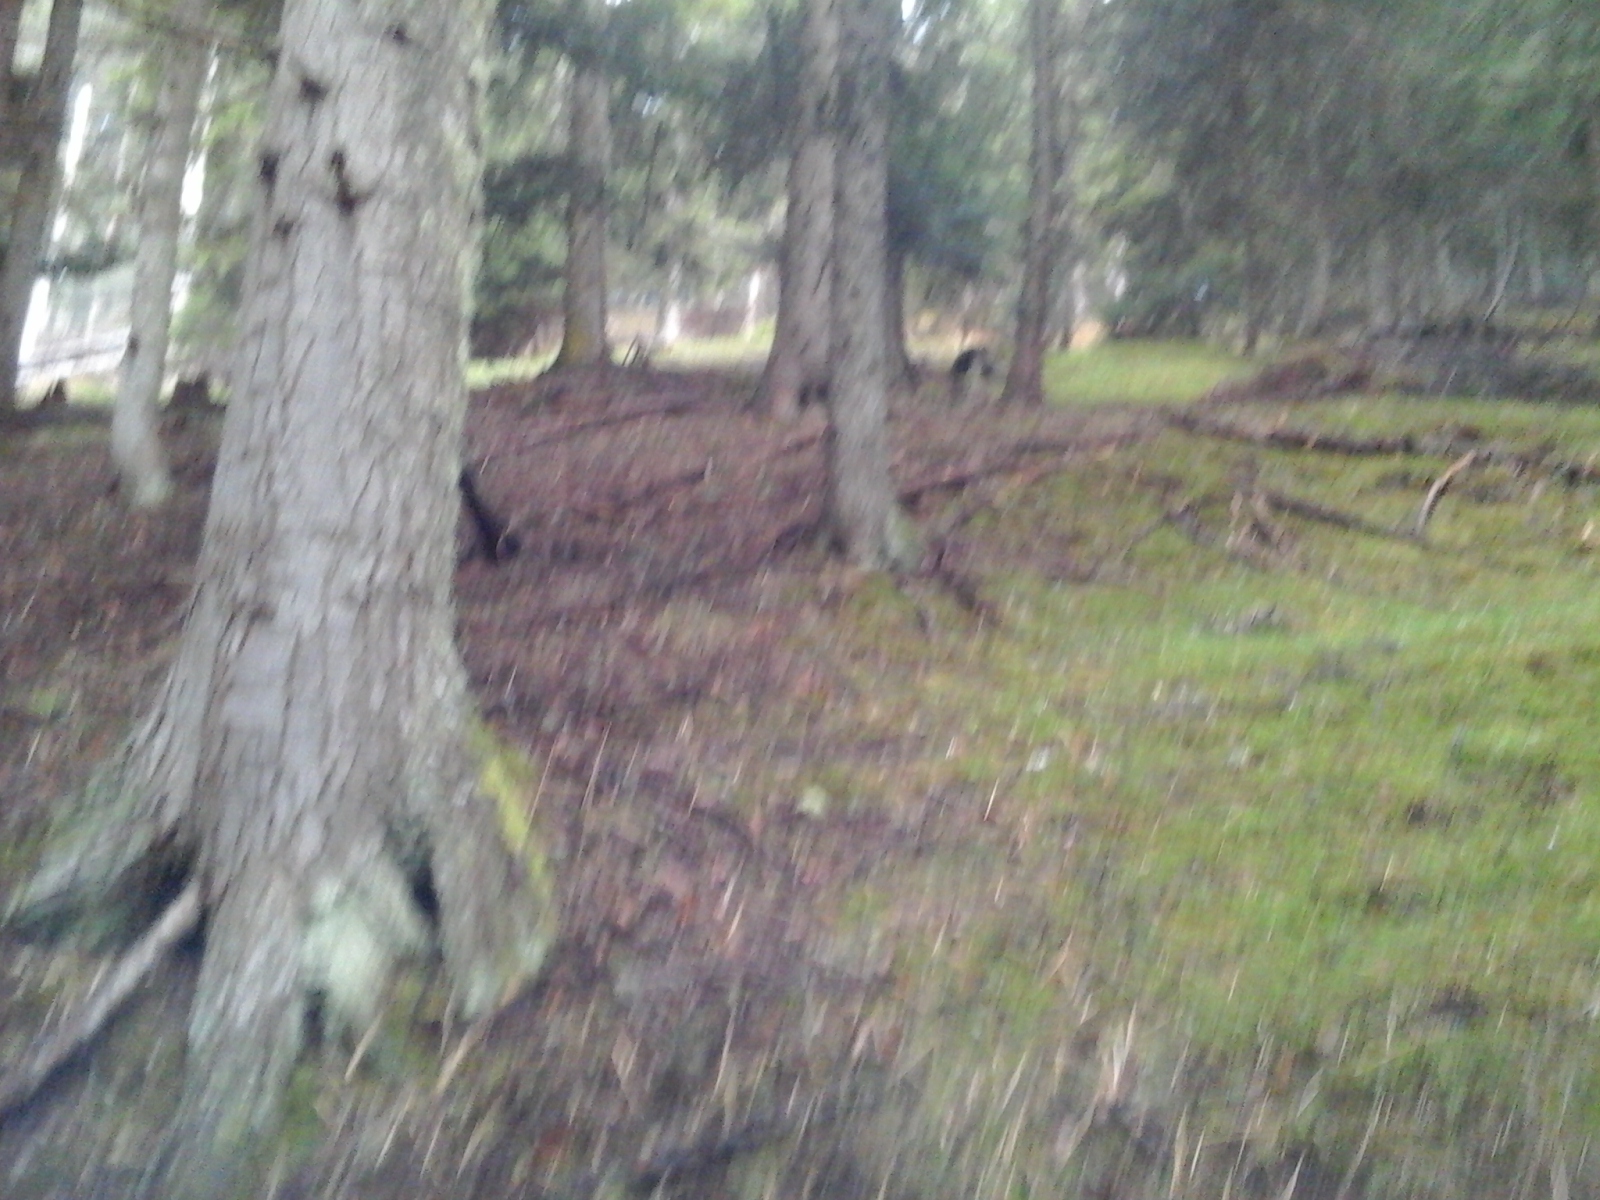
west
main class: Woodland
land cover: Spruce dominated coniferous woodland
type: alpine coniferous forest
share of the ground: > 75 %
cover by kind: coniferous forest trees 95 %, lichens and mosses 5 %
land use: Forestry
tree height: > 5 m
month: May
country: IT
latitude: 46.3807
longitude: 11.1816
